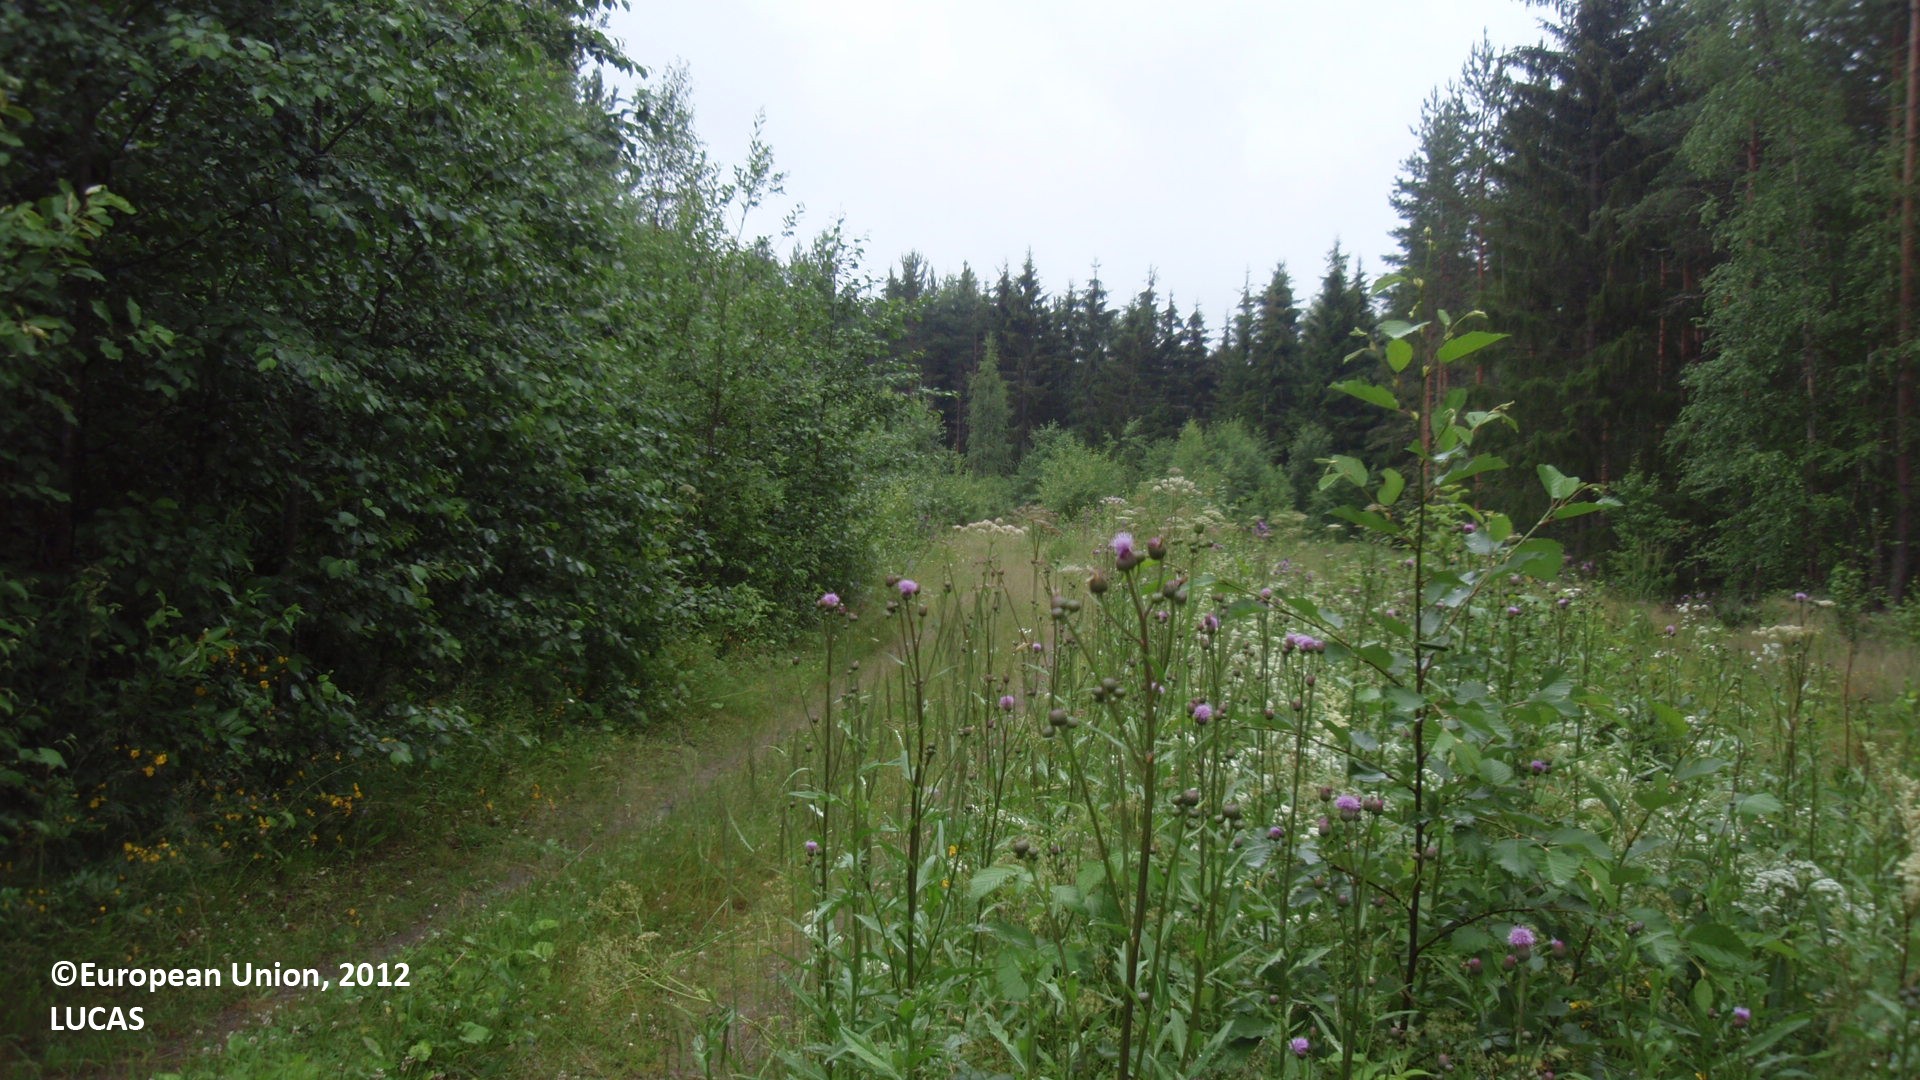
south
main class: Grassland
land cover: Spontaneously vegetated surfaces
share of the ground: > 75 %
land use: Forestry
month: July
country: FI
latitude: 61.1112
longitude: 28.8012
